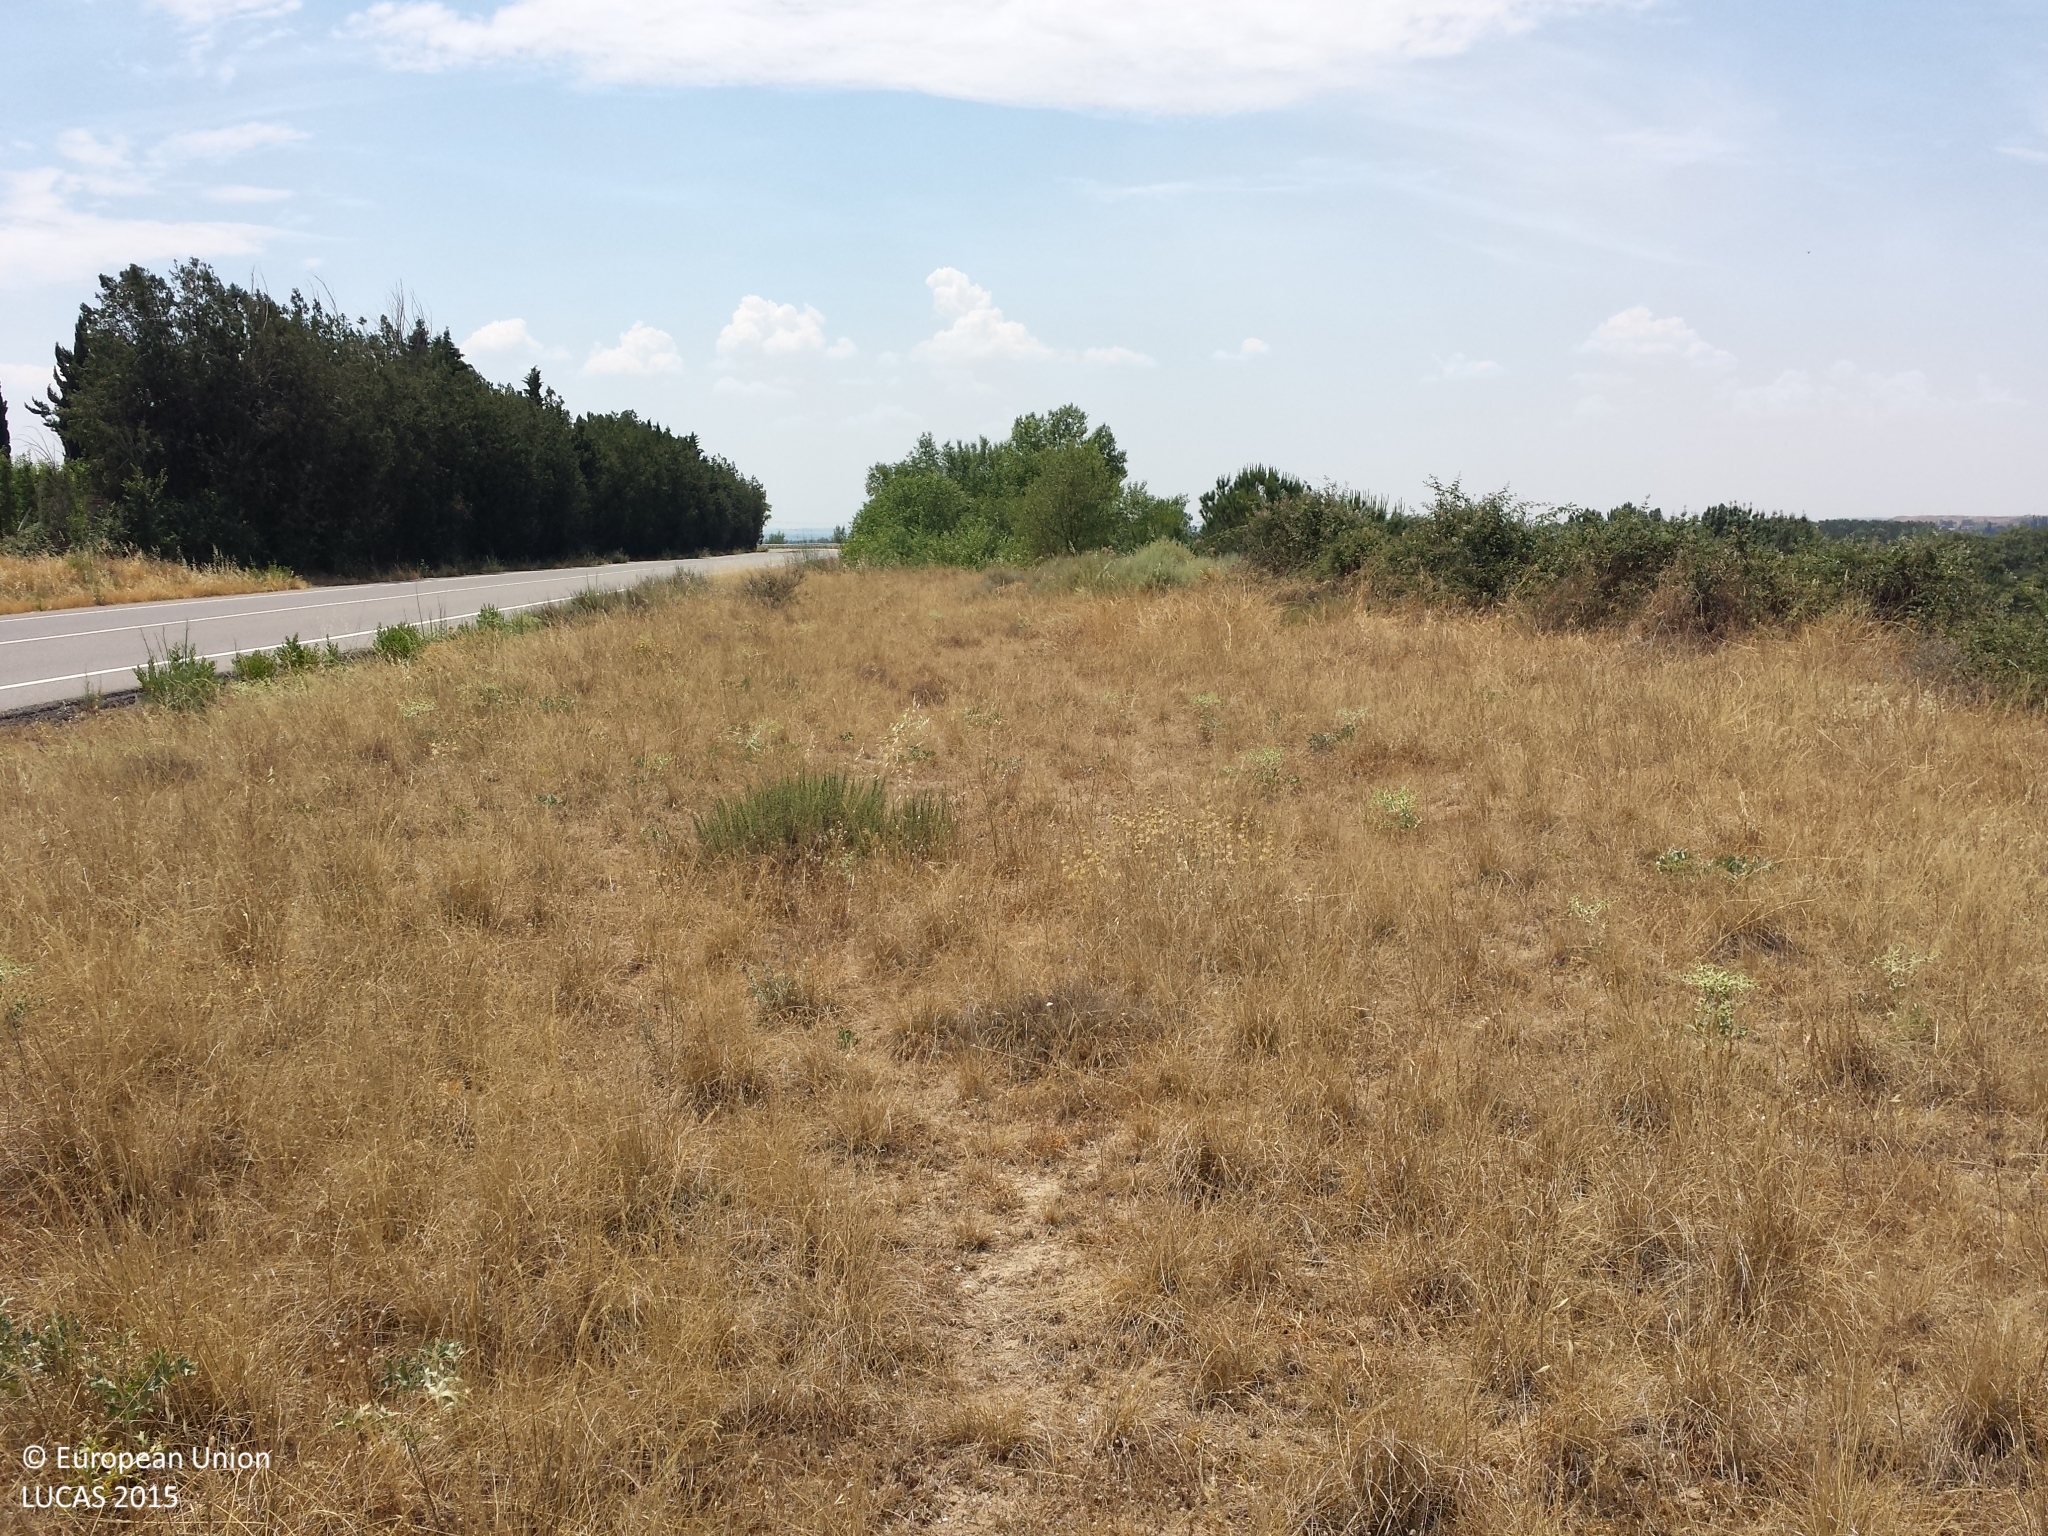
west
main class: Grassland
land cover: Grassland without tree/shrub cover
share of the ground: > 75 %
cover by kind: herbaceous plants 85 %, consolidated bare surface 10 %, shrubs 5 %
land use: Semi-natural and natural areas not in use
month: June
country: ES
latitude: 41.5818
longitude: 0.6202
